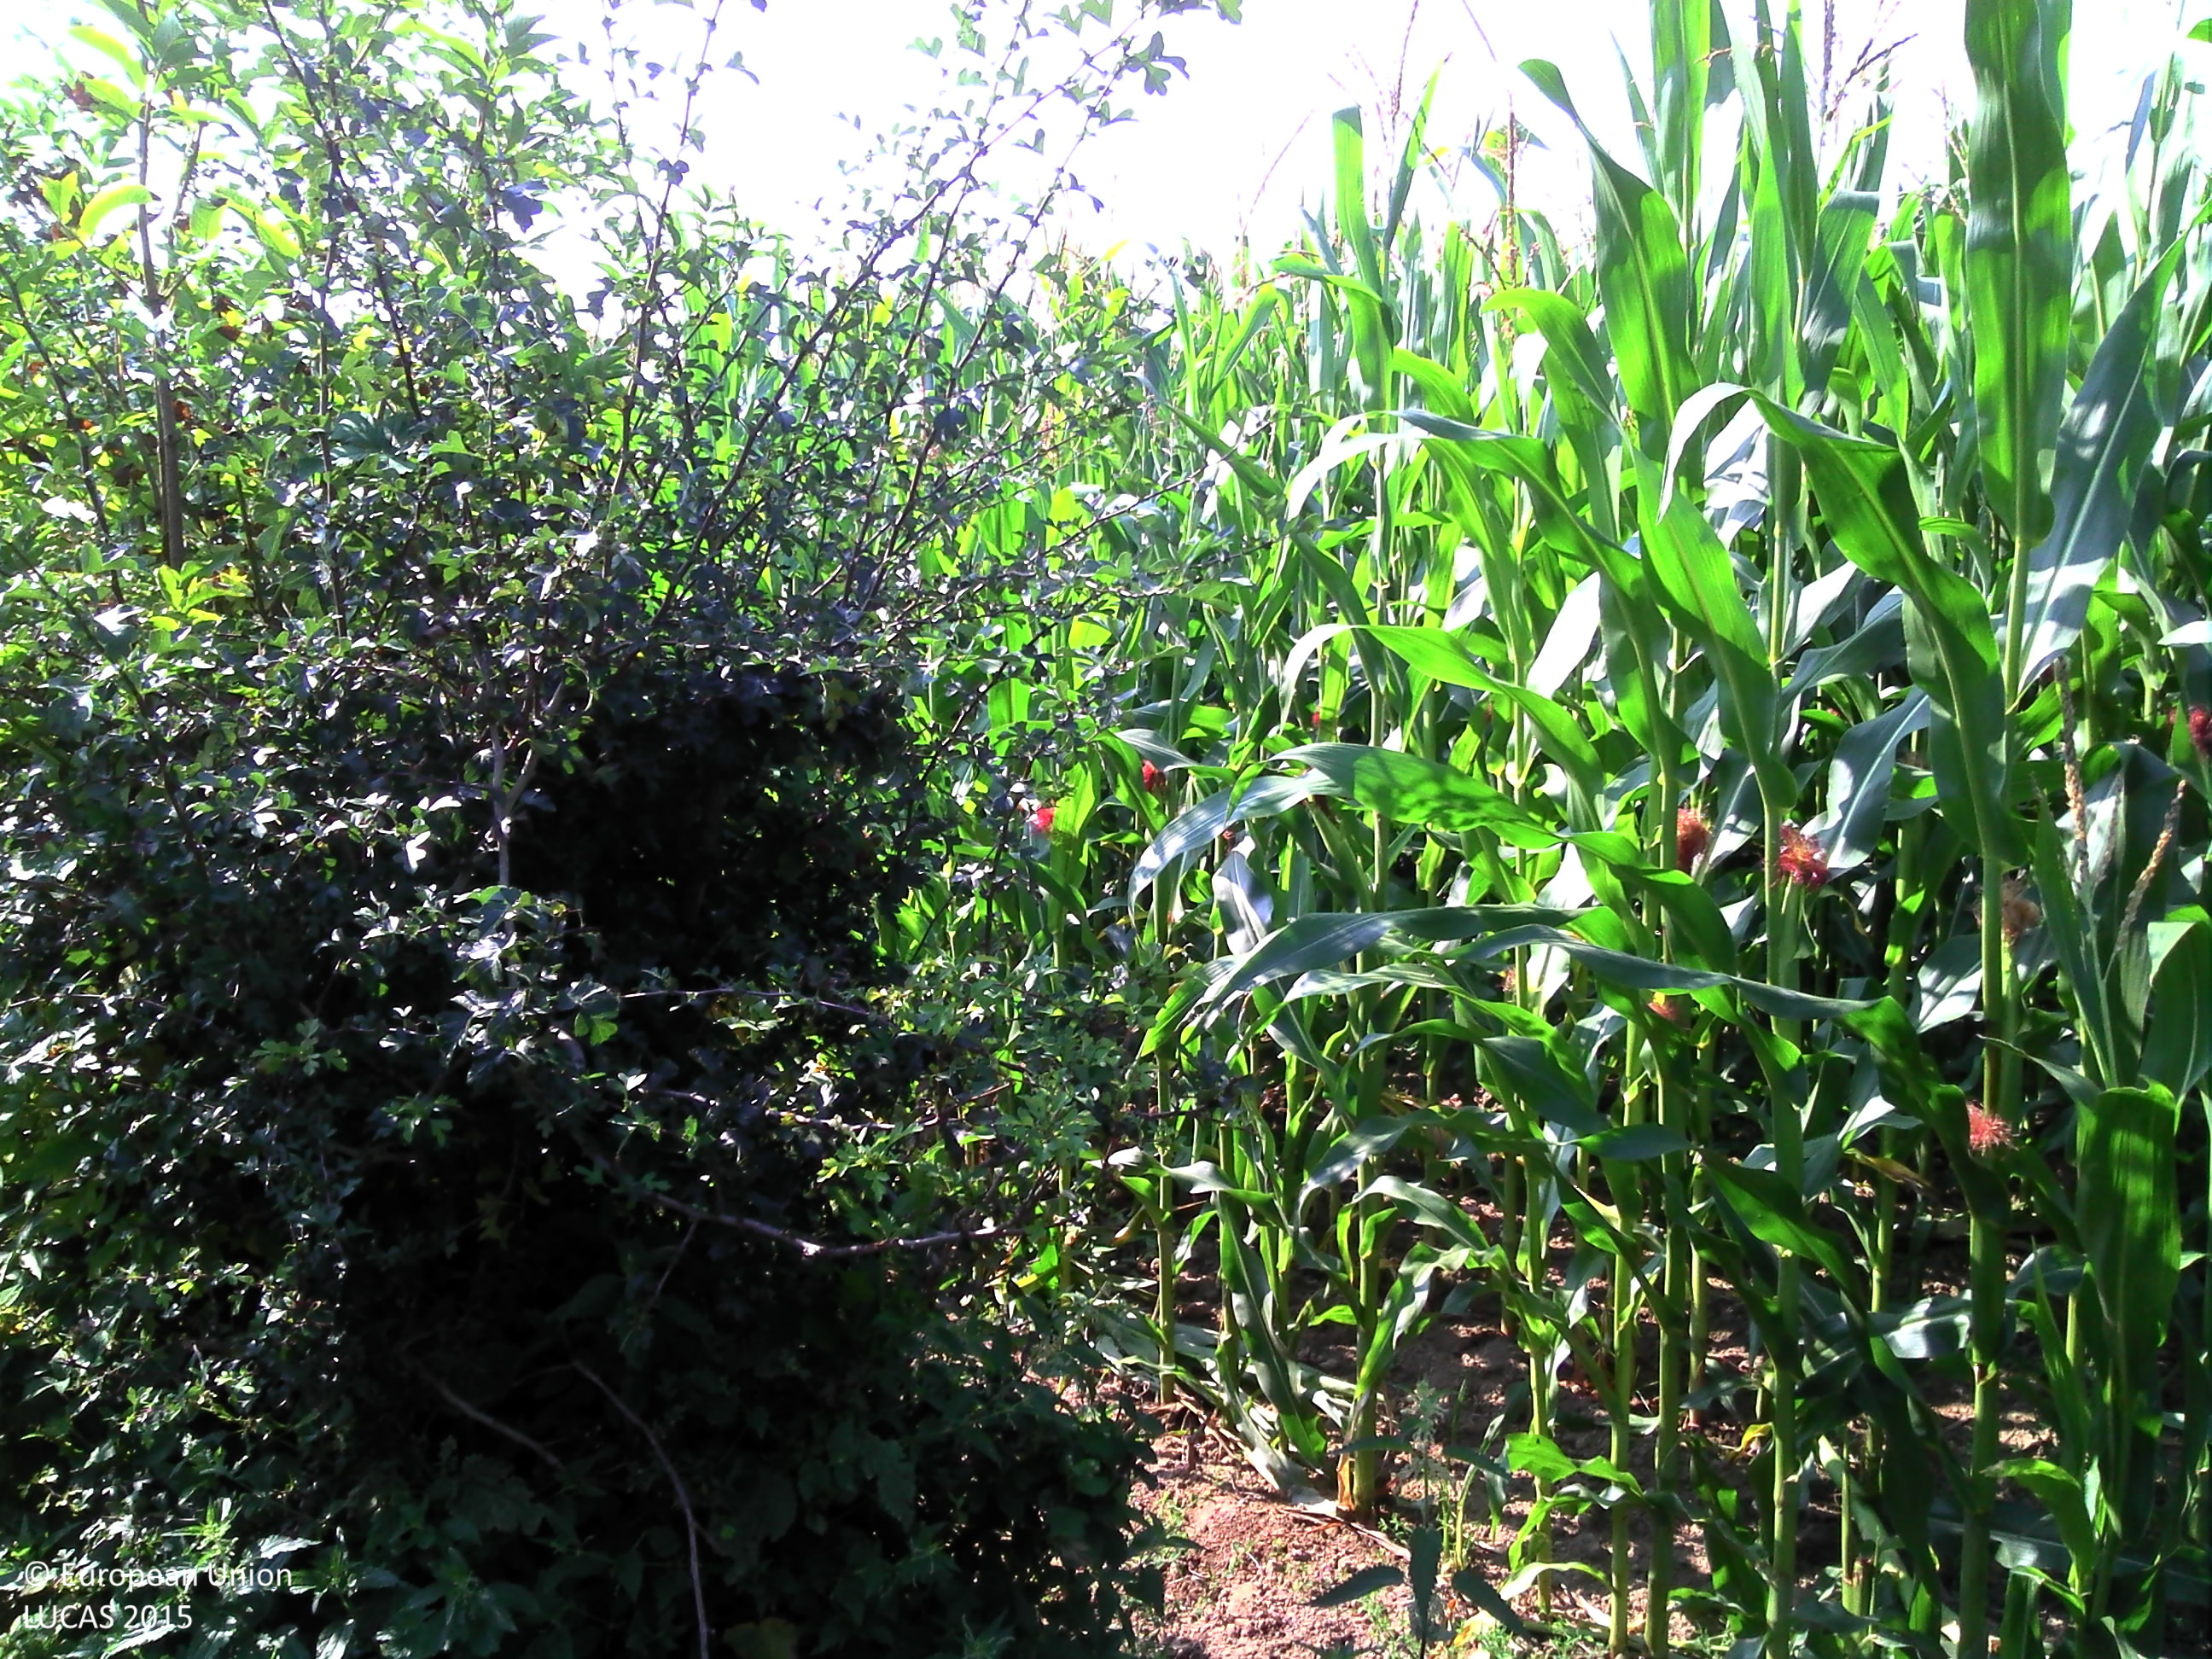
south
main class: Cropland
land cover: Maize
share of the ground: > 75 %
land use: Agriculture (excluding fallow land and kitchen gardens)
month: August
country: BE
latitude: 50.7208
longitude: 5.8485
